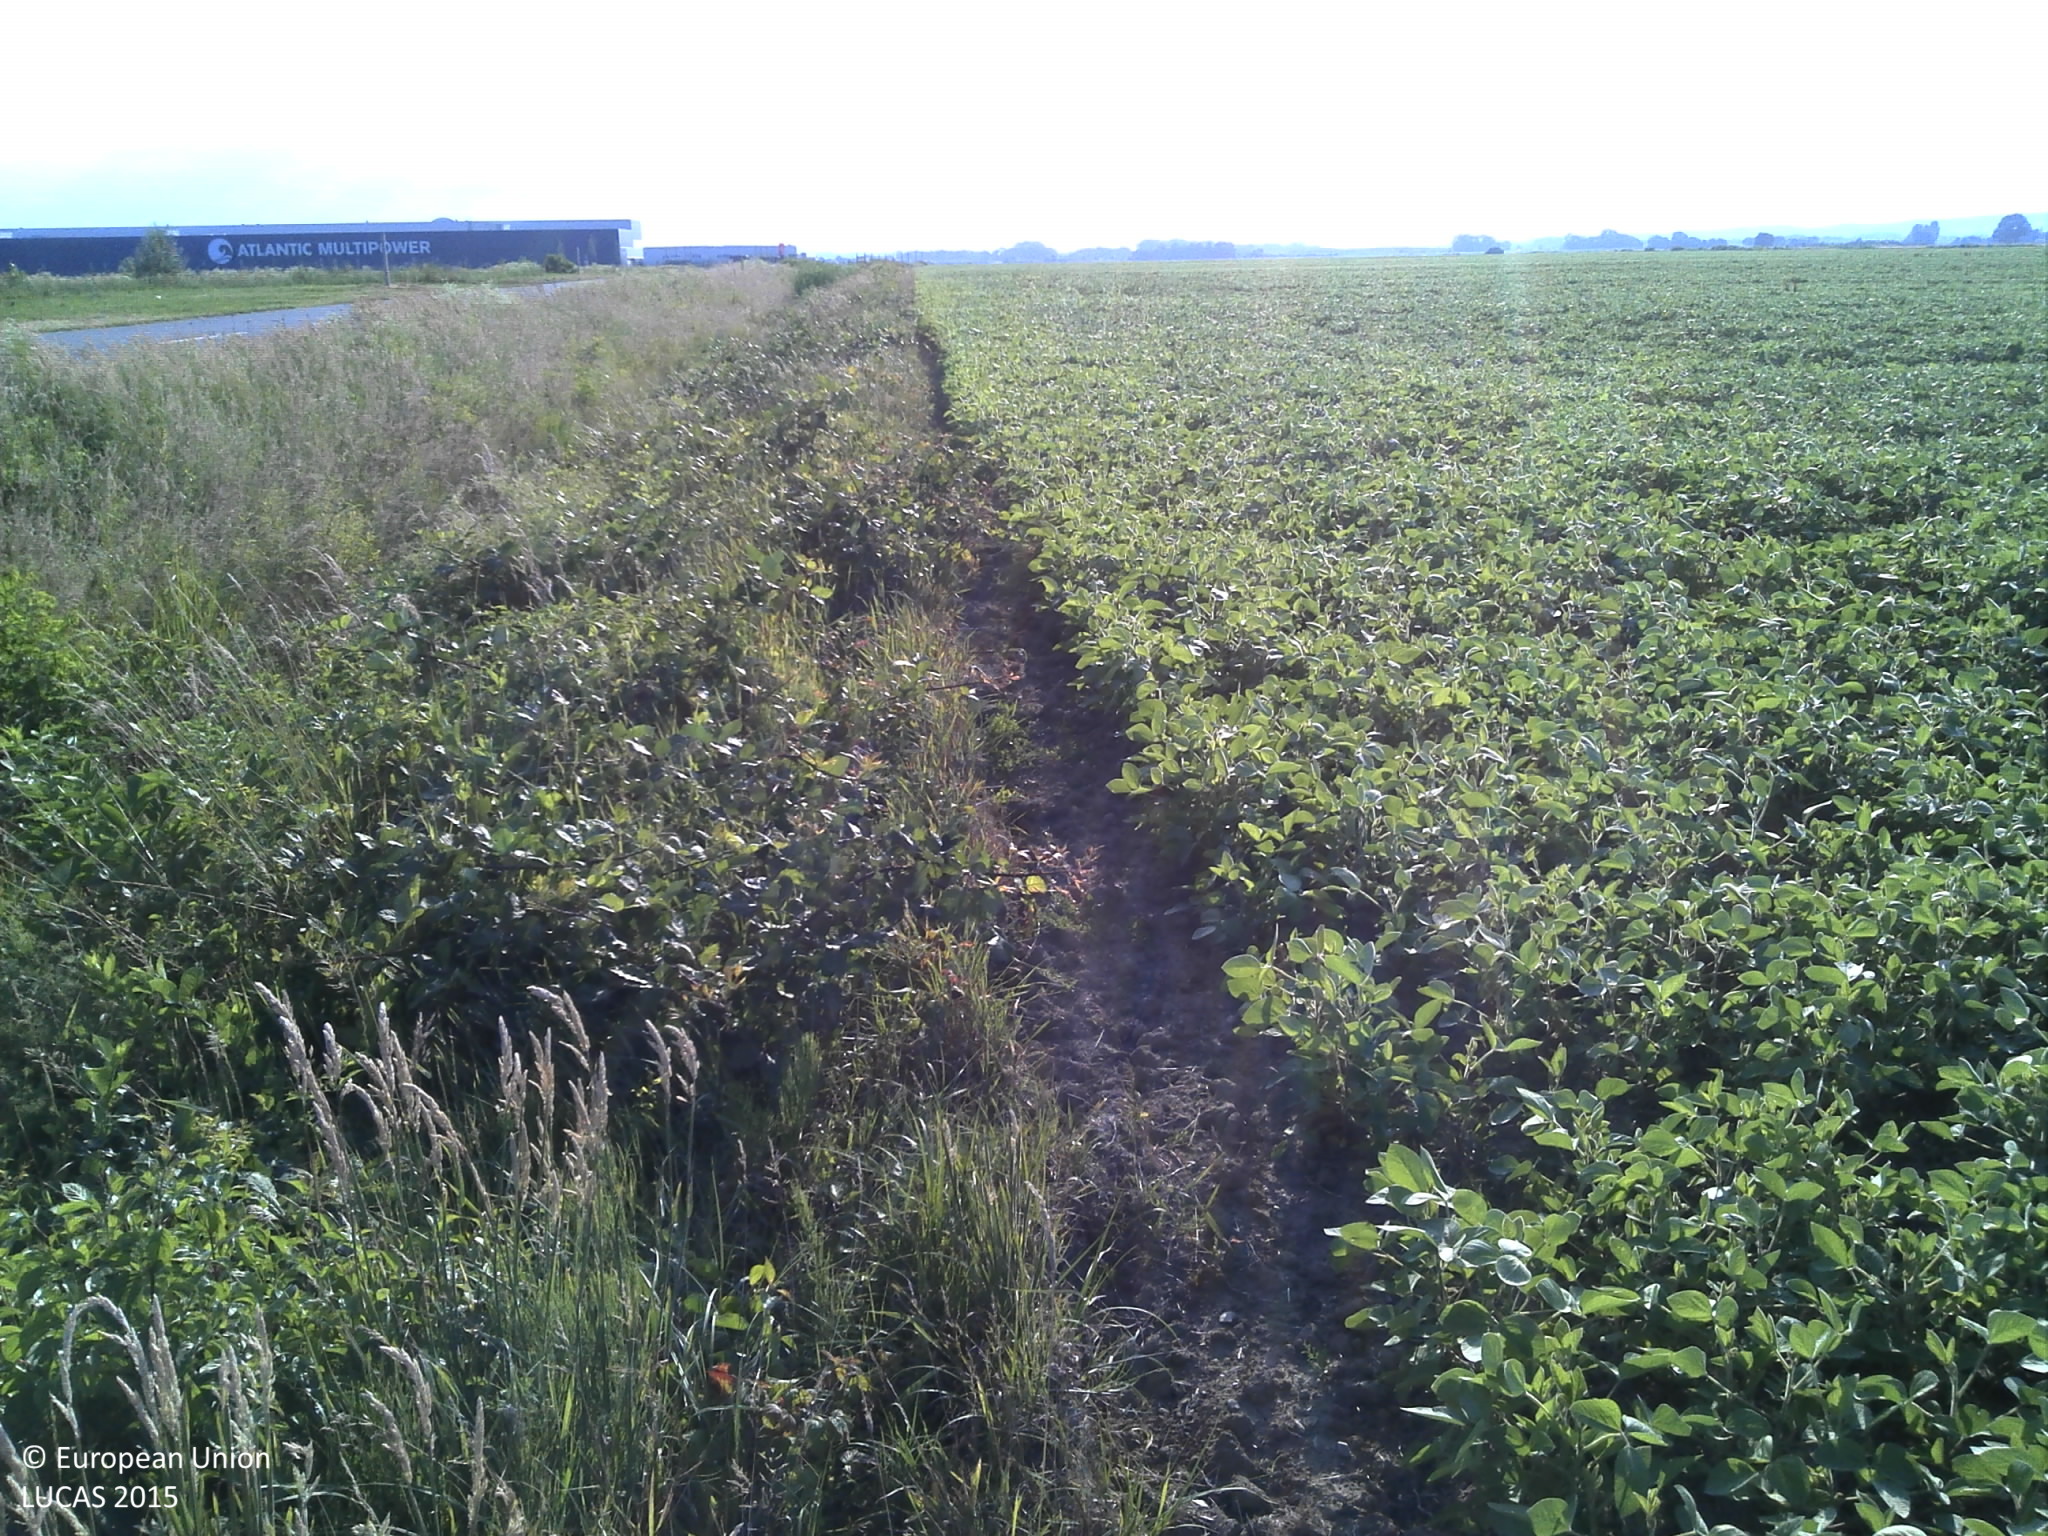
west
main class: Cropland
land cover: Soya
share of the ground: 25 - 50 %
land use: Agriculture (excluding fallow land and kitchen gardens)
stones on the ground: < 10 %
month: June
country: HR
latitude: 45.2282
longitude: 17.3744
